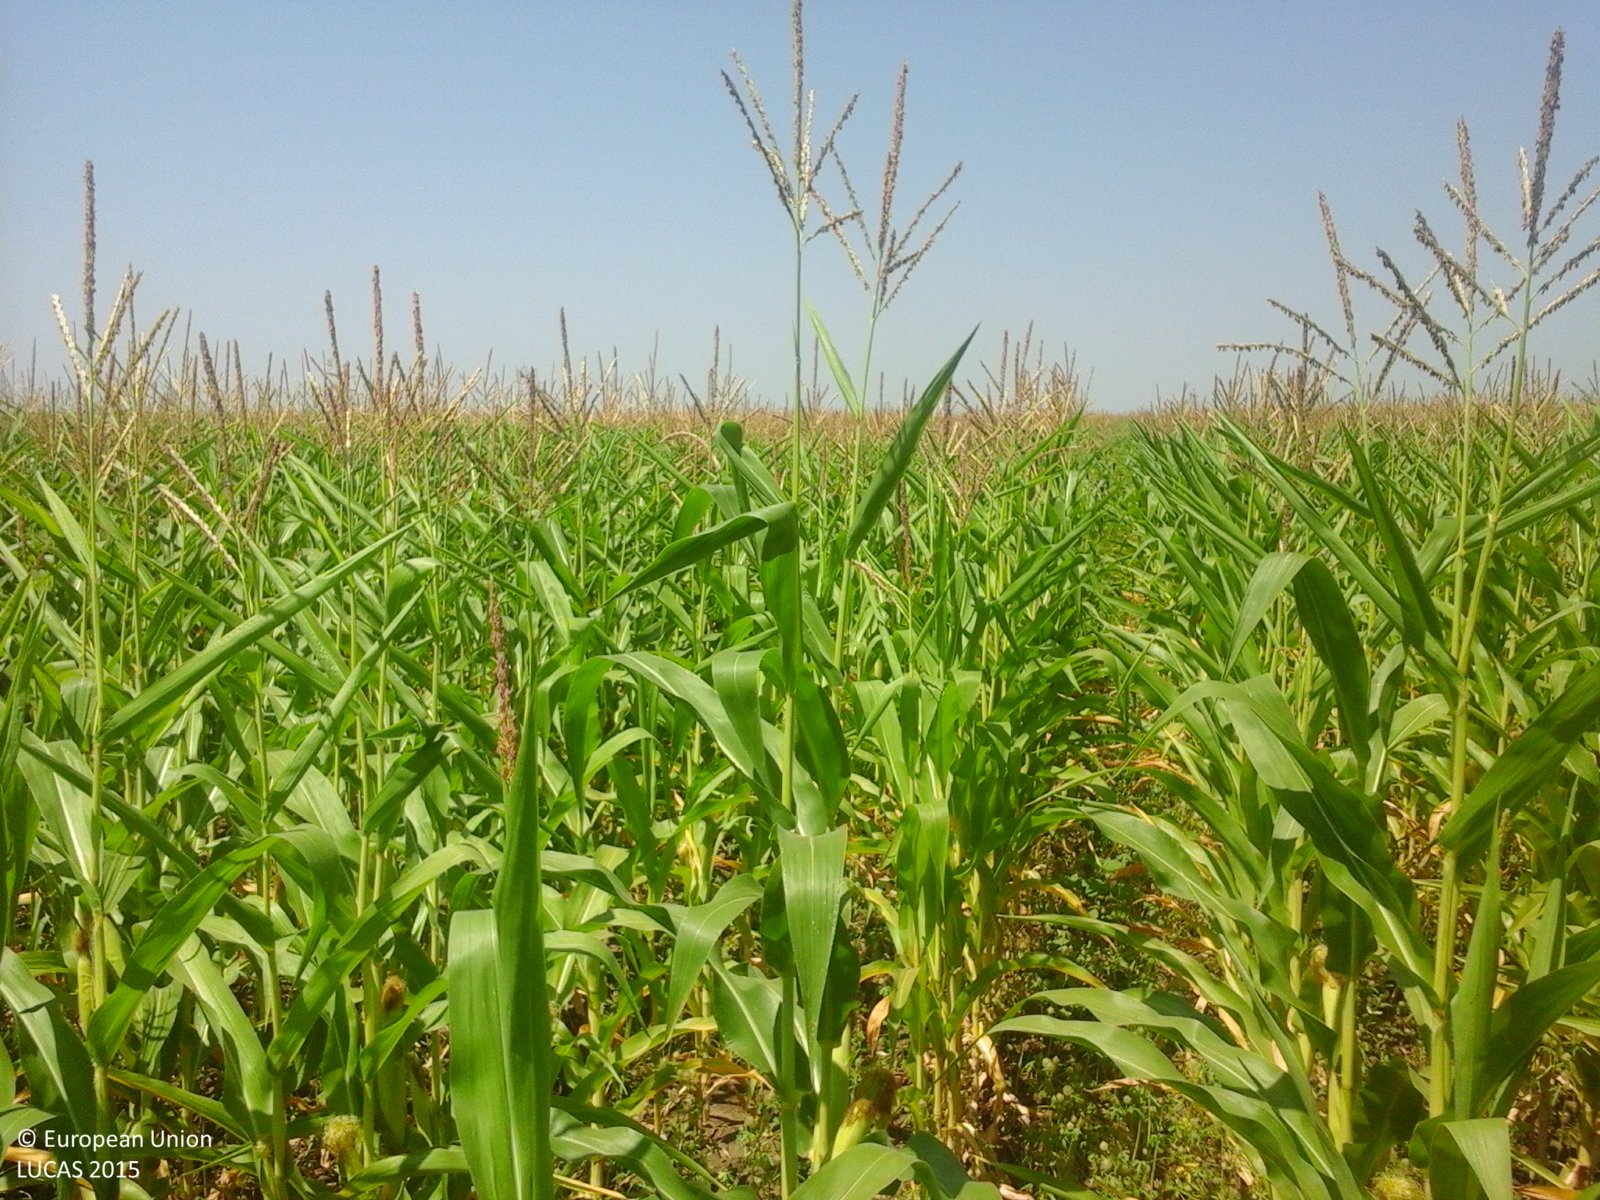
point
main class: Cropland
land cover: Maize
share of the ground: > 75 %
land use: Agriculture (excluding fallow land and kitchen gardens)
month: July
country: RO
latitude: 44.7548
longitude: 26.7876
